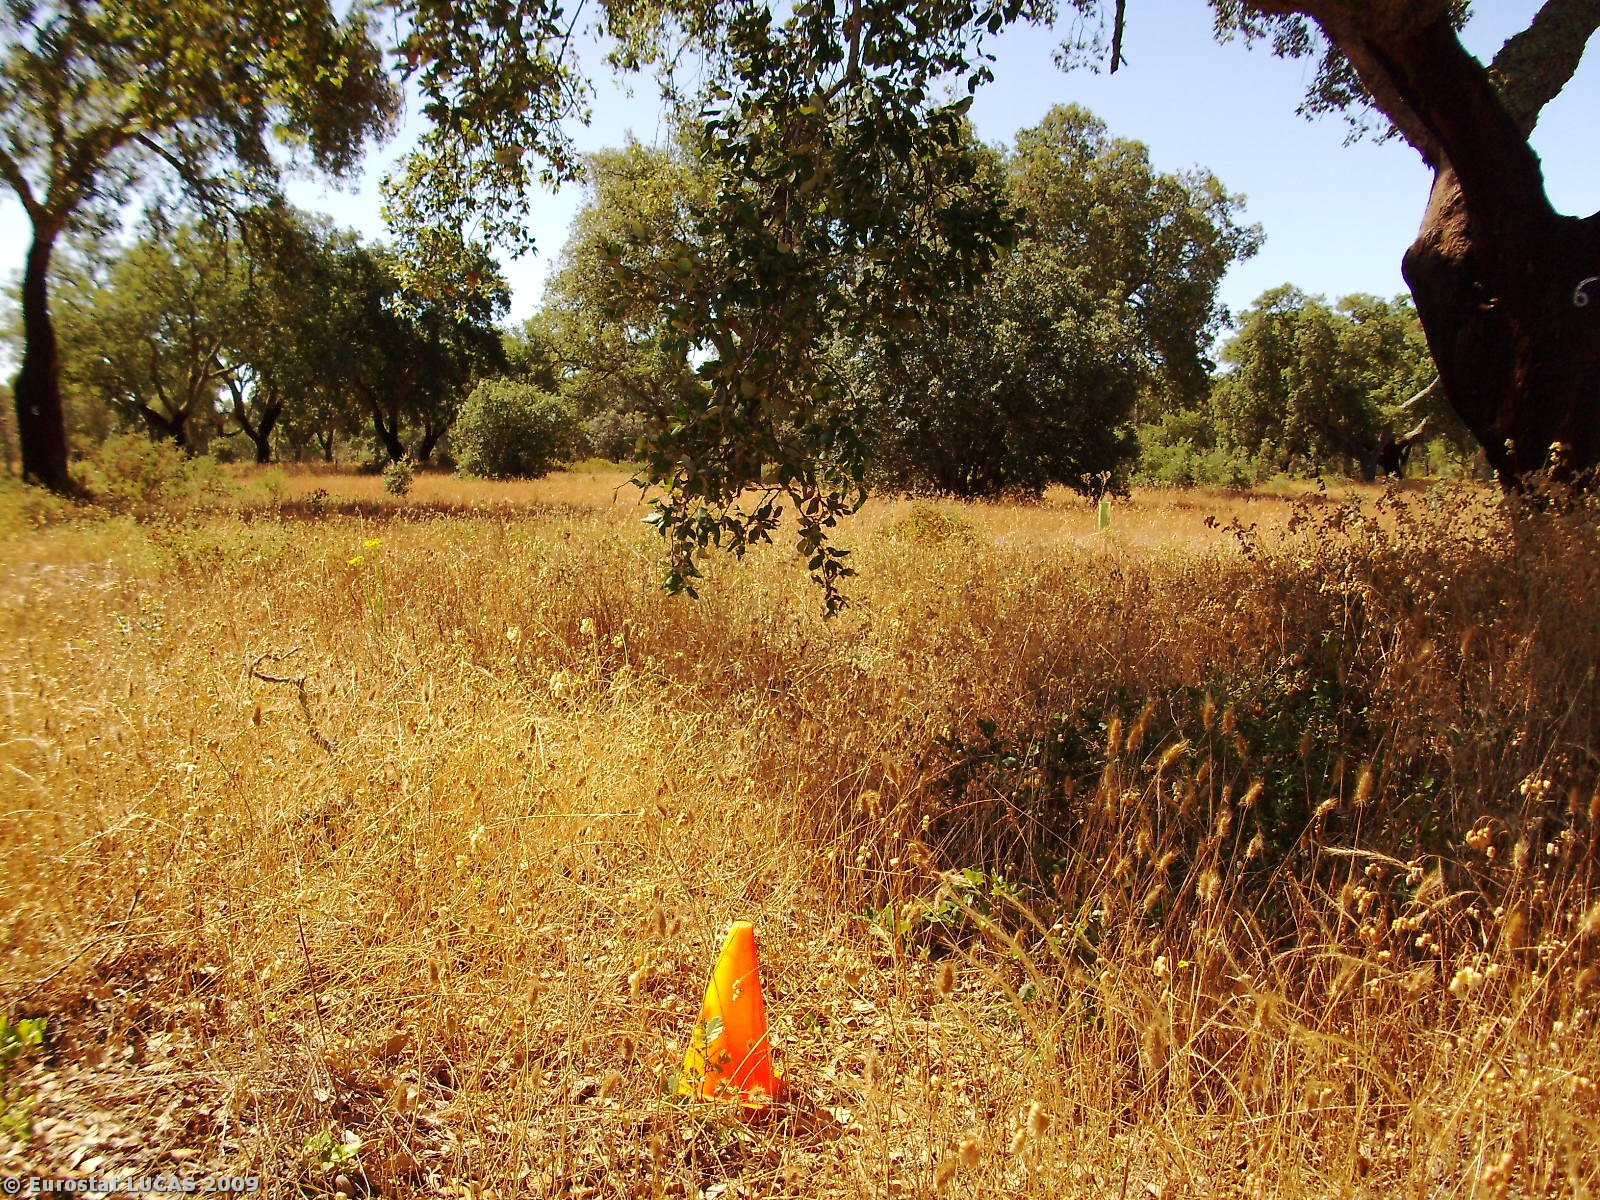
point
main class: Woodland
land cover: Broadleaved woodland
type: broadleaved evergreen forest
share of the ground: 25 - 50 %
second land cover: Spontaneously vegetated surfaces
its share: 25 - 50 %
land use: Forestry
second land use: Fallow land
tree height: > 5 m
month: July
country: PT
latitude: 37.7886
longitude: -8.3977
